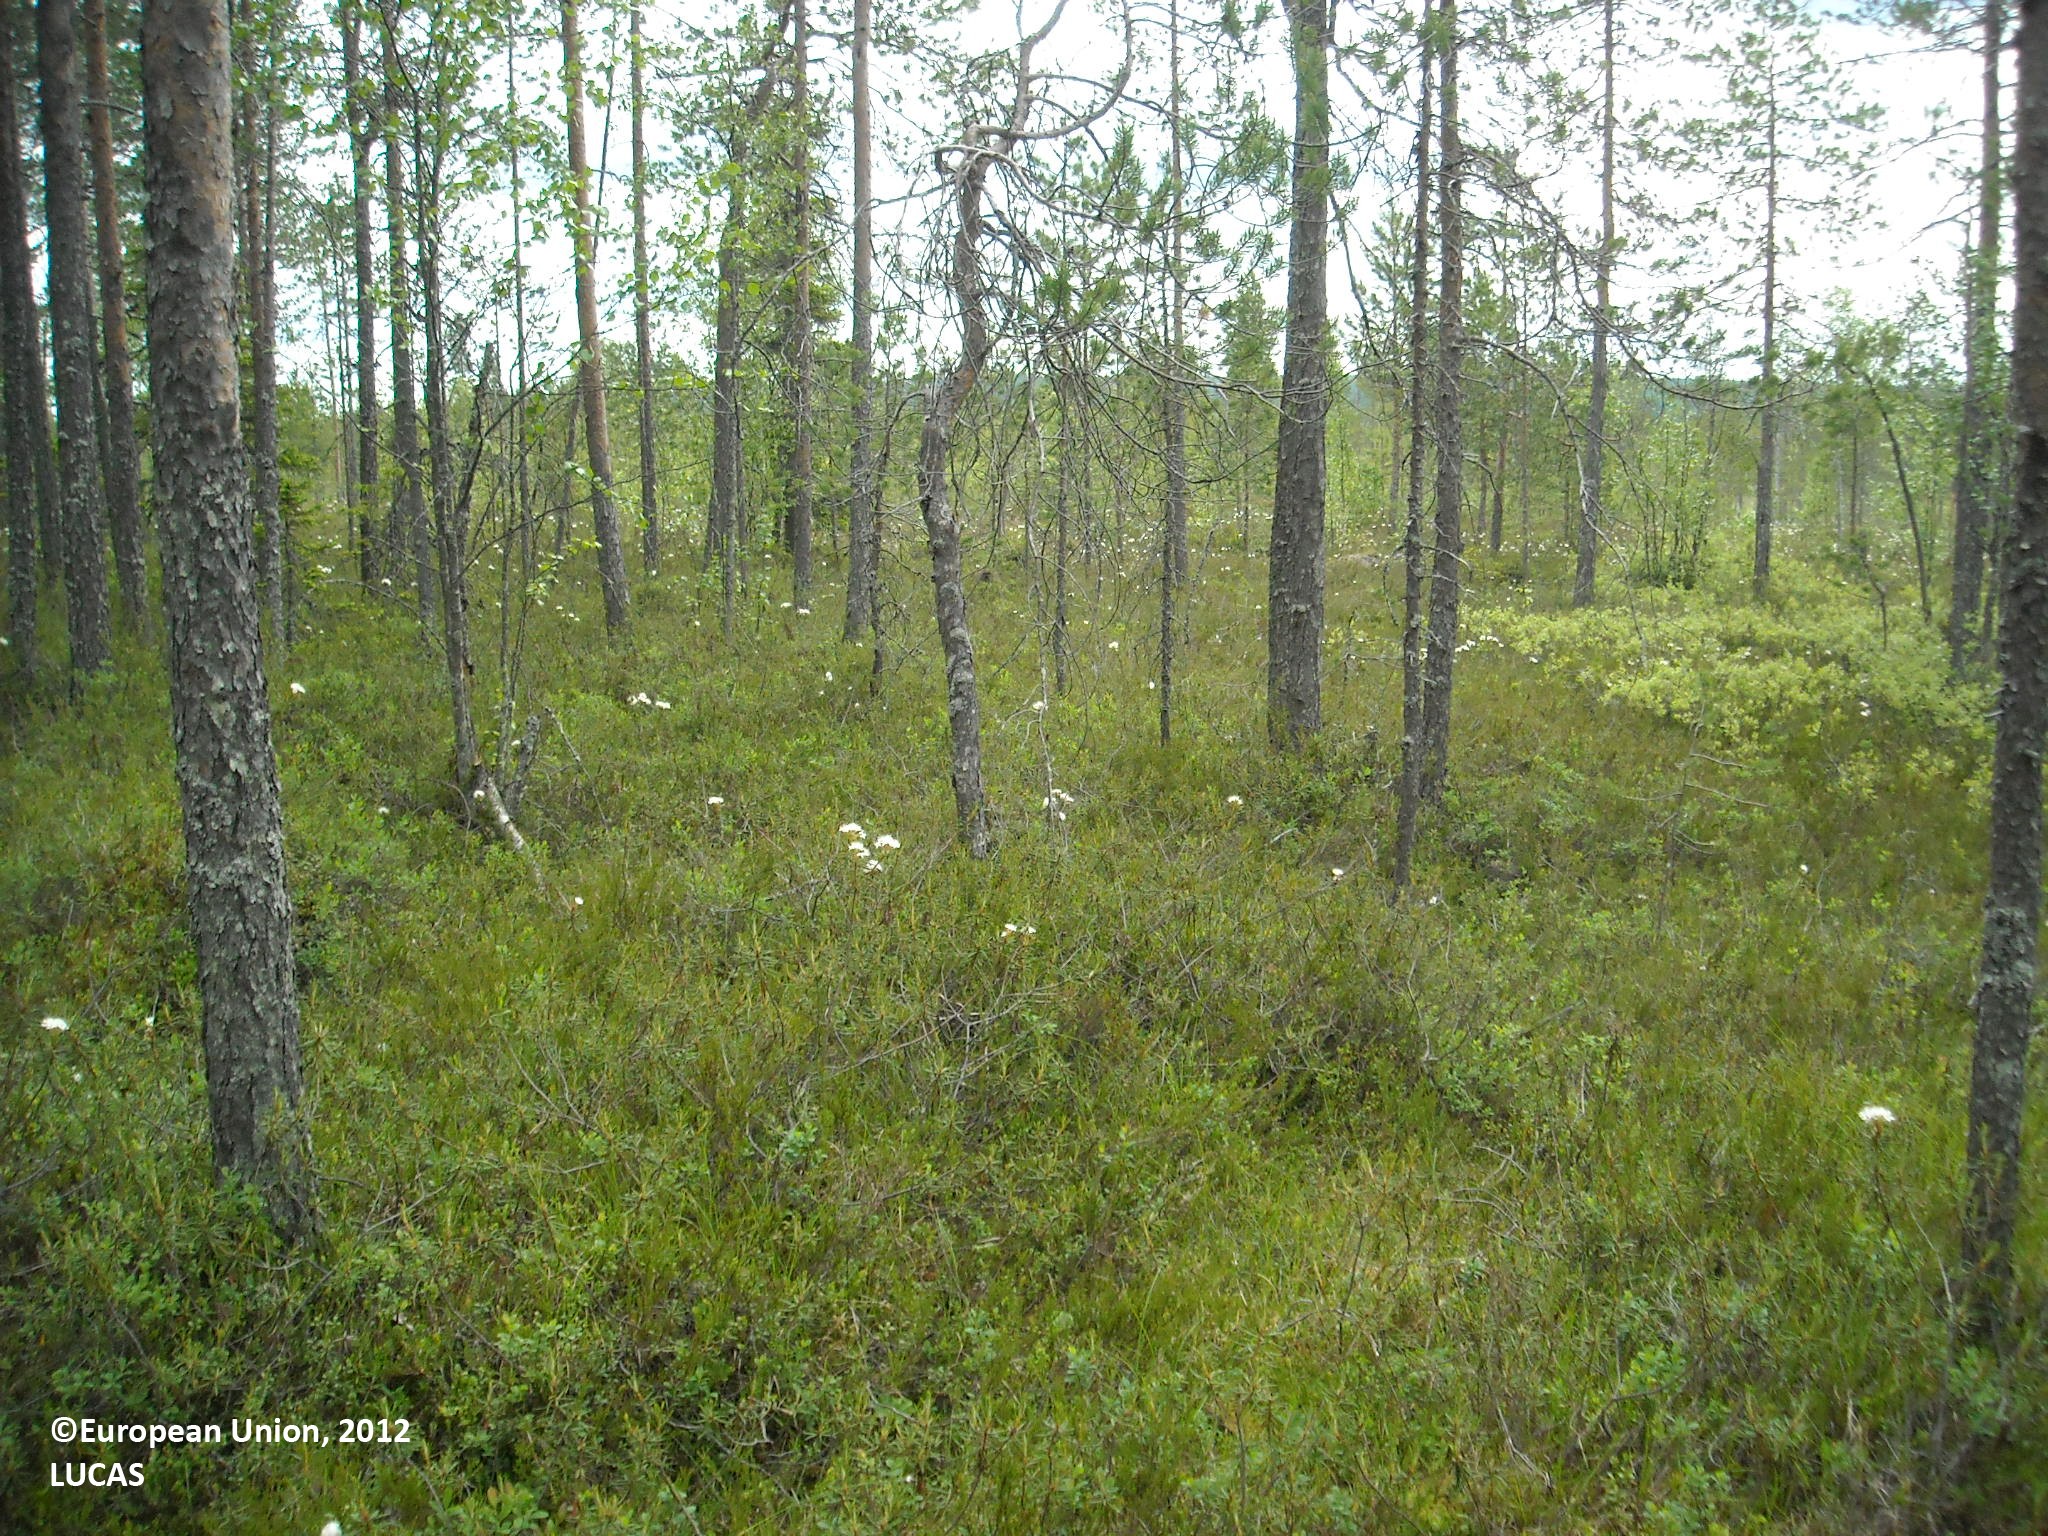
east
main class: Woodland
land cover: Pine dominated coniferous woodland
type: mire and swamp forests
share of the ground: > 75 %
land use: Forestry
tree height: > 5 m
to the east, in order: Pine dominated coniferous woodland; Ditches and canals; Pine dominated mixed woodland; Ditches and canals; Grass margins; Paved roads, cycling and walking lanes
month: June
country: FI
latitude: 64.8332
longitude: 27.7877
